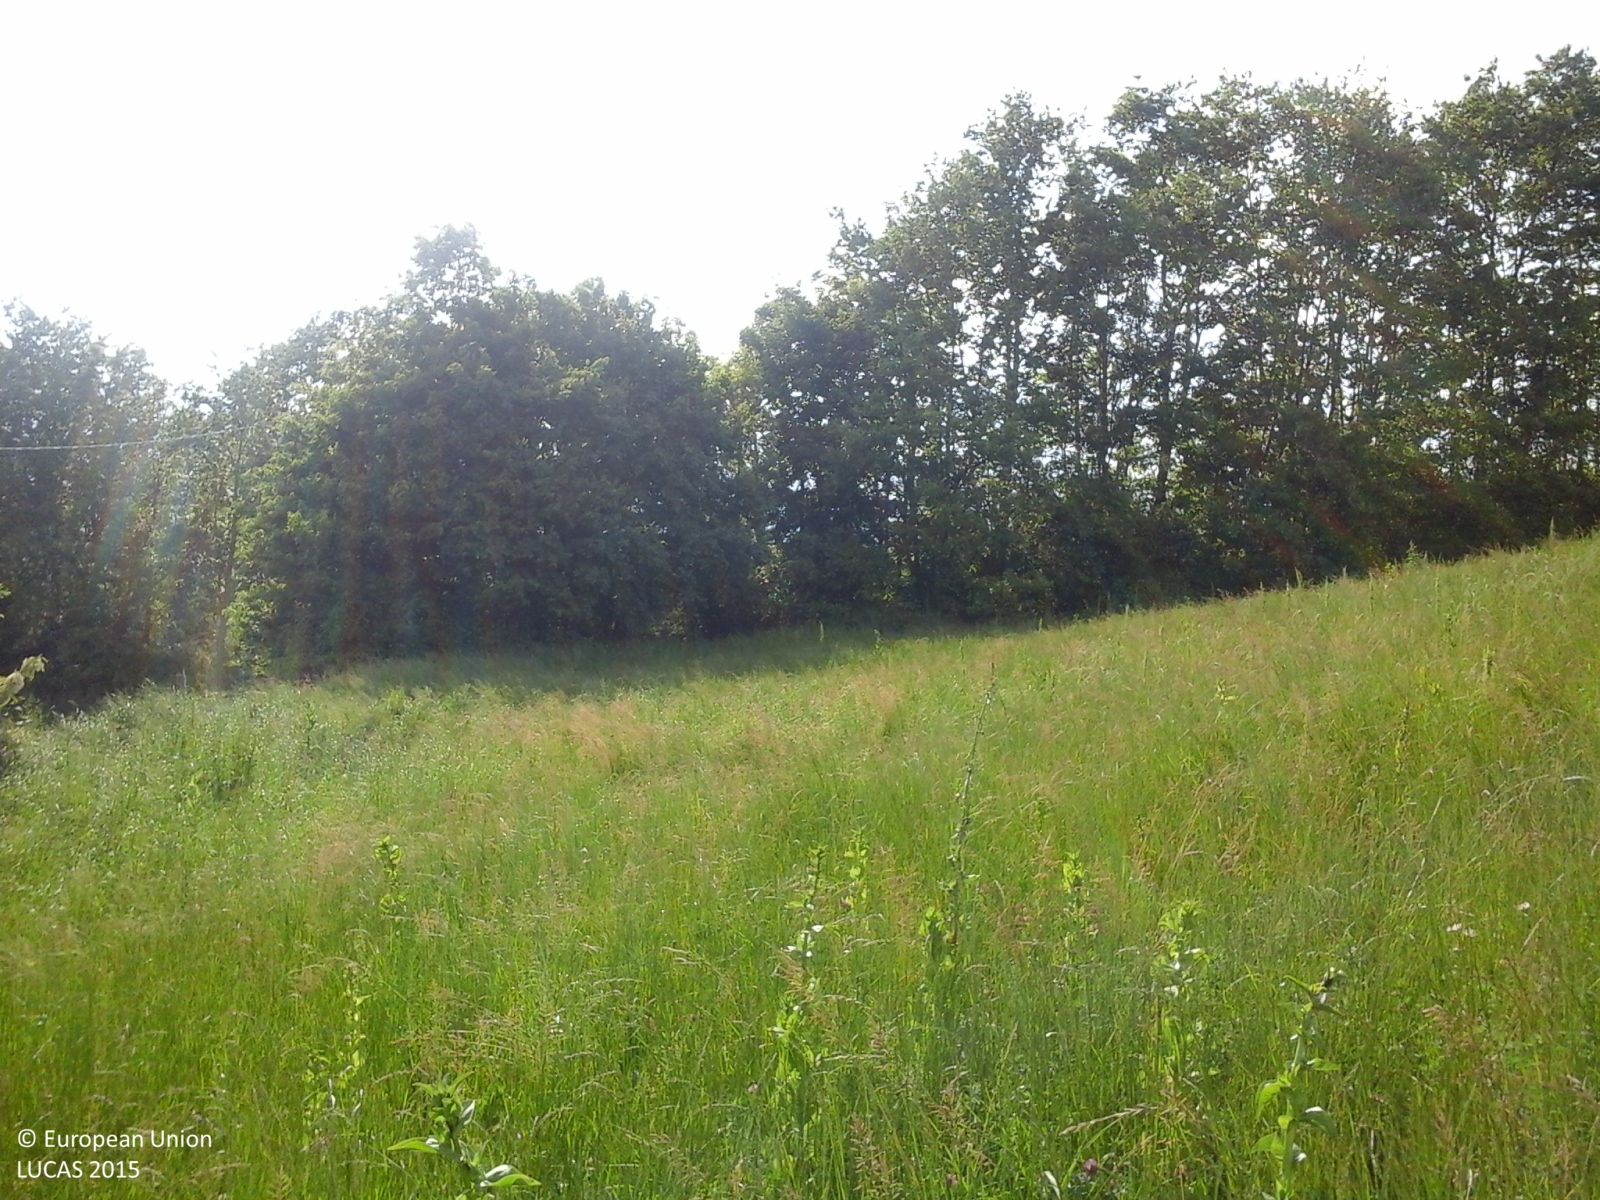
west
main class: Grassland
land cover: Spontaneously vegetated surfaces
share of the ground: > 75 %
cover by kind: herbaceous plants 100 %
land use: Agriculture (excluding fallow land and kitchen gardens)
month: May
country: IT
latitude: 44.5123
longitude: 9.6611
